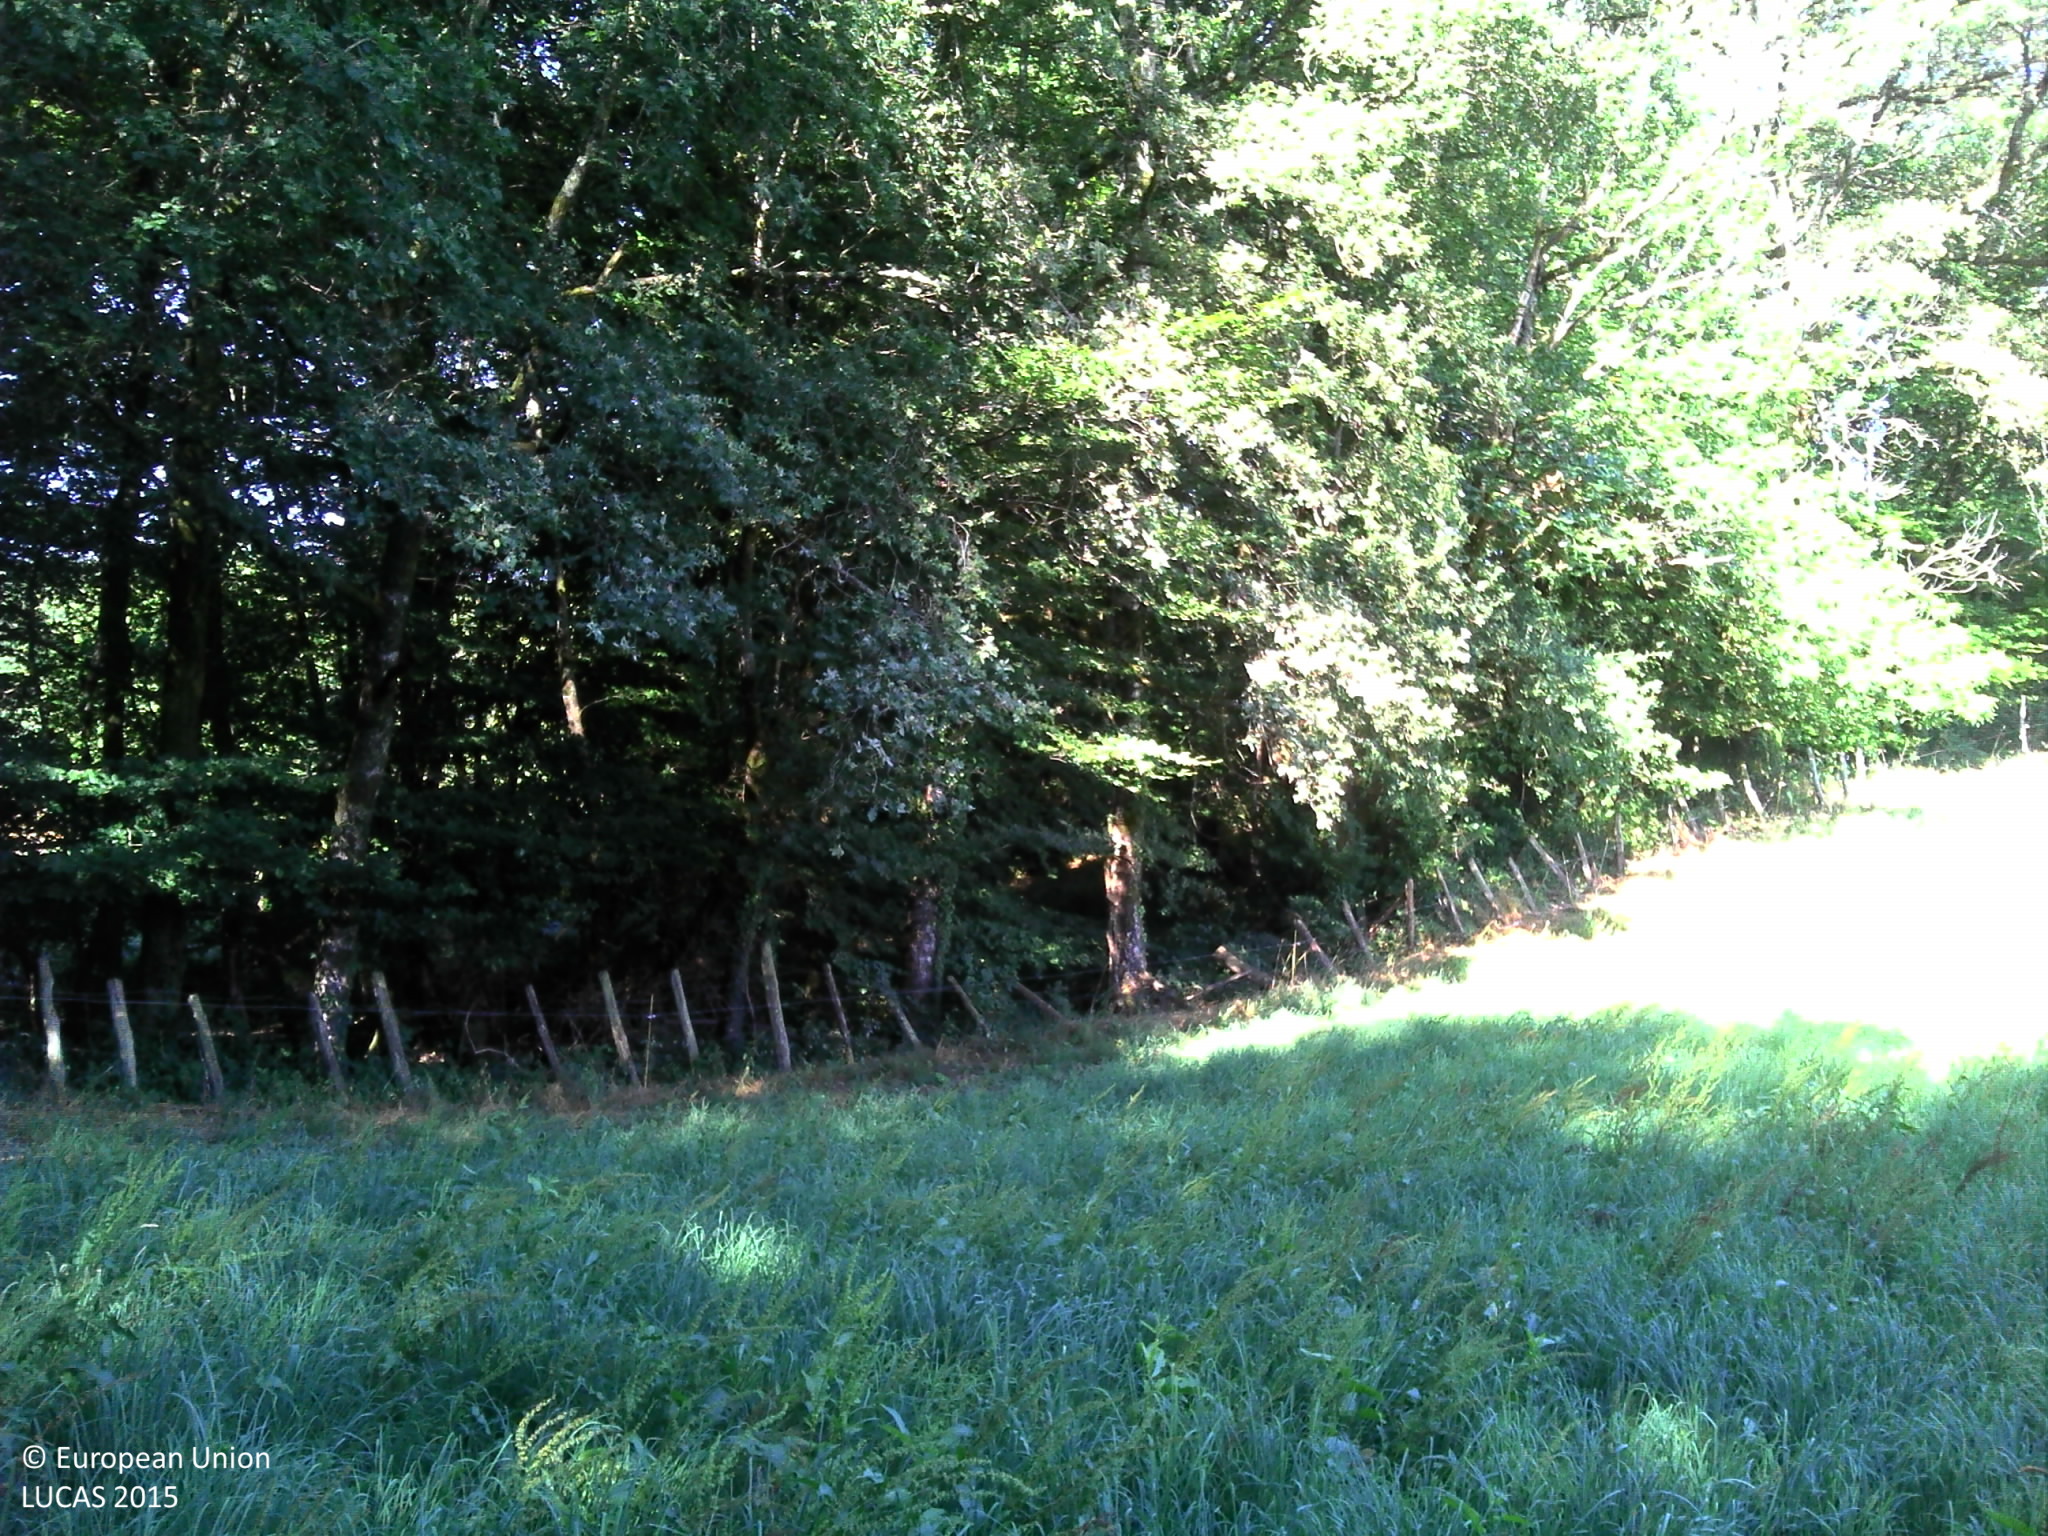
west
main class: Grassland
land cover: Grassland without tree/shrub cover
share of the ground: > 75 %
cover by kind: herbaceous plants 100 %
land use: Agriculture (excluding fallow land and kitchen gardens)
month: July
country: FR
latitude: 45.5360
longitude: 1.6578
